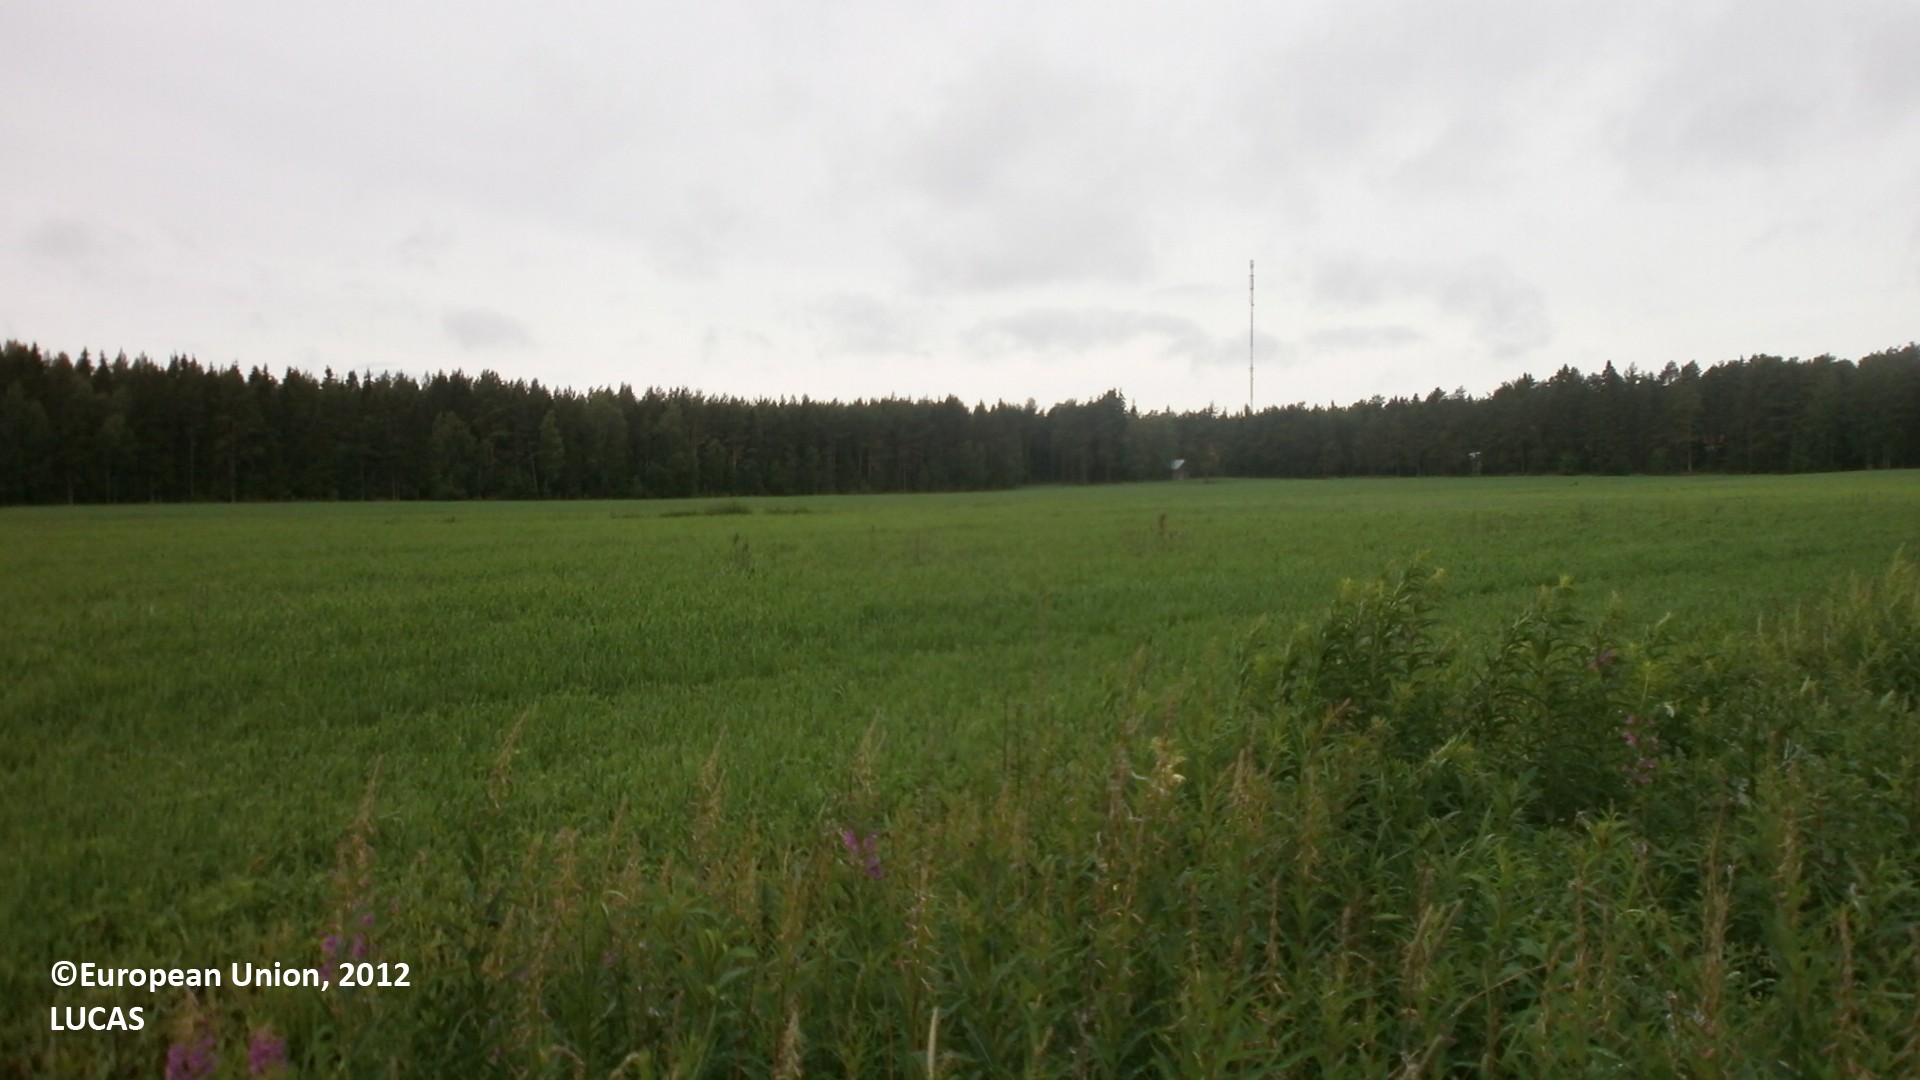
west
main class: Grassland
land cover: Grassland without tree/shrub cover
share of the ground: > 75 %
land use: Agriculture (excluding fallow land and kitchen gardens)
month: July
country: FI
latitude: 64.6009
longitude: 24.4217
